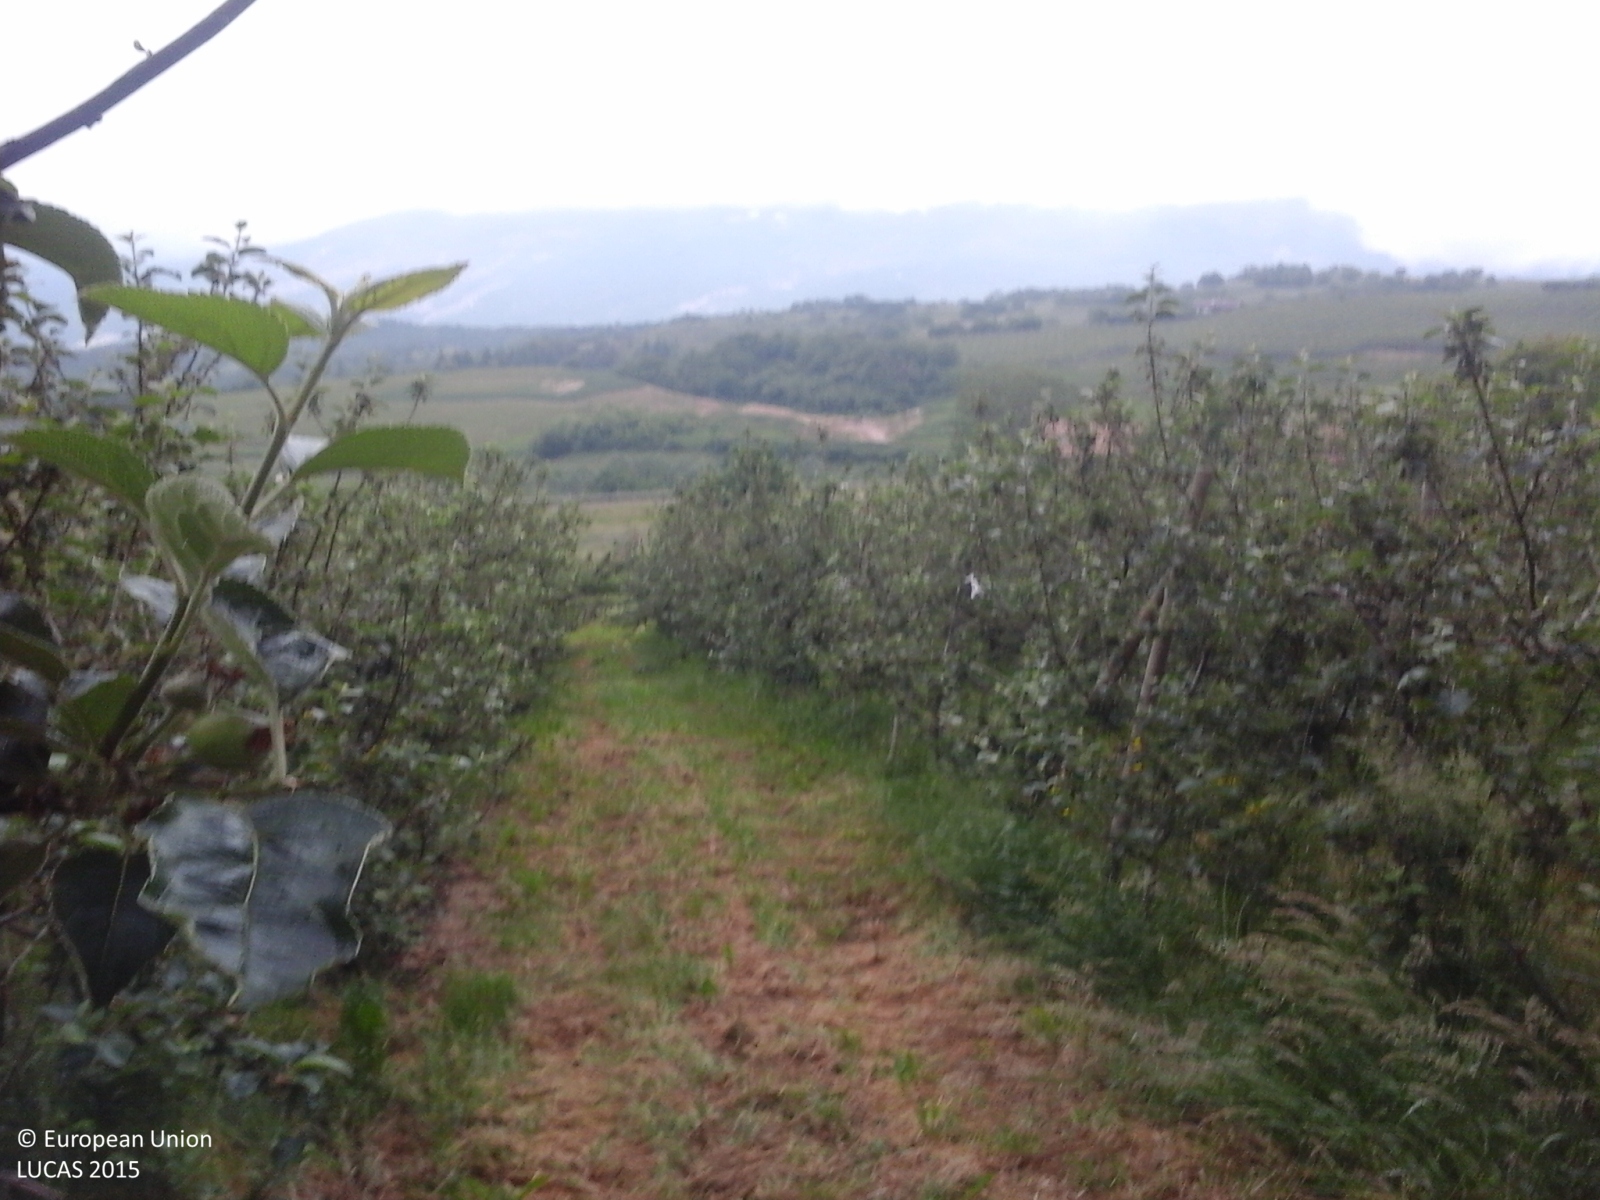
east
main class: Cropland
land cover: Apple fruit
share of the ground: 25 - 50 %
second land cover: Grassland without tree/shrub cover
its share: > 75 %
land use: Agriculture (excluding fallow land and kitchen gardens)
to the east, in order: Apple fruit; Grassland without tree/shrub cover; Potatoes; Grass margins; Dry stone walls; Tracks; Shrubland without tree cover; Grassland without tree/shrub cover; Other bare soil; Grass margins; Paved roads, cycling and walking lanes; Grassland without tree/shrub cover; Vineyards; Broadleaved woodland
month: May
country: IT
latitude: 45.8244
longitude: 10.9639
